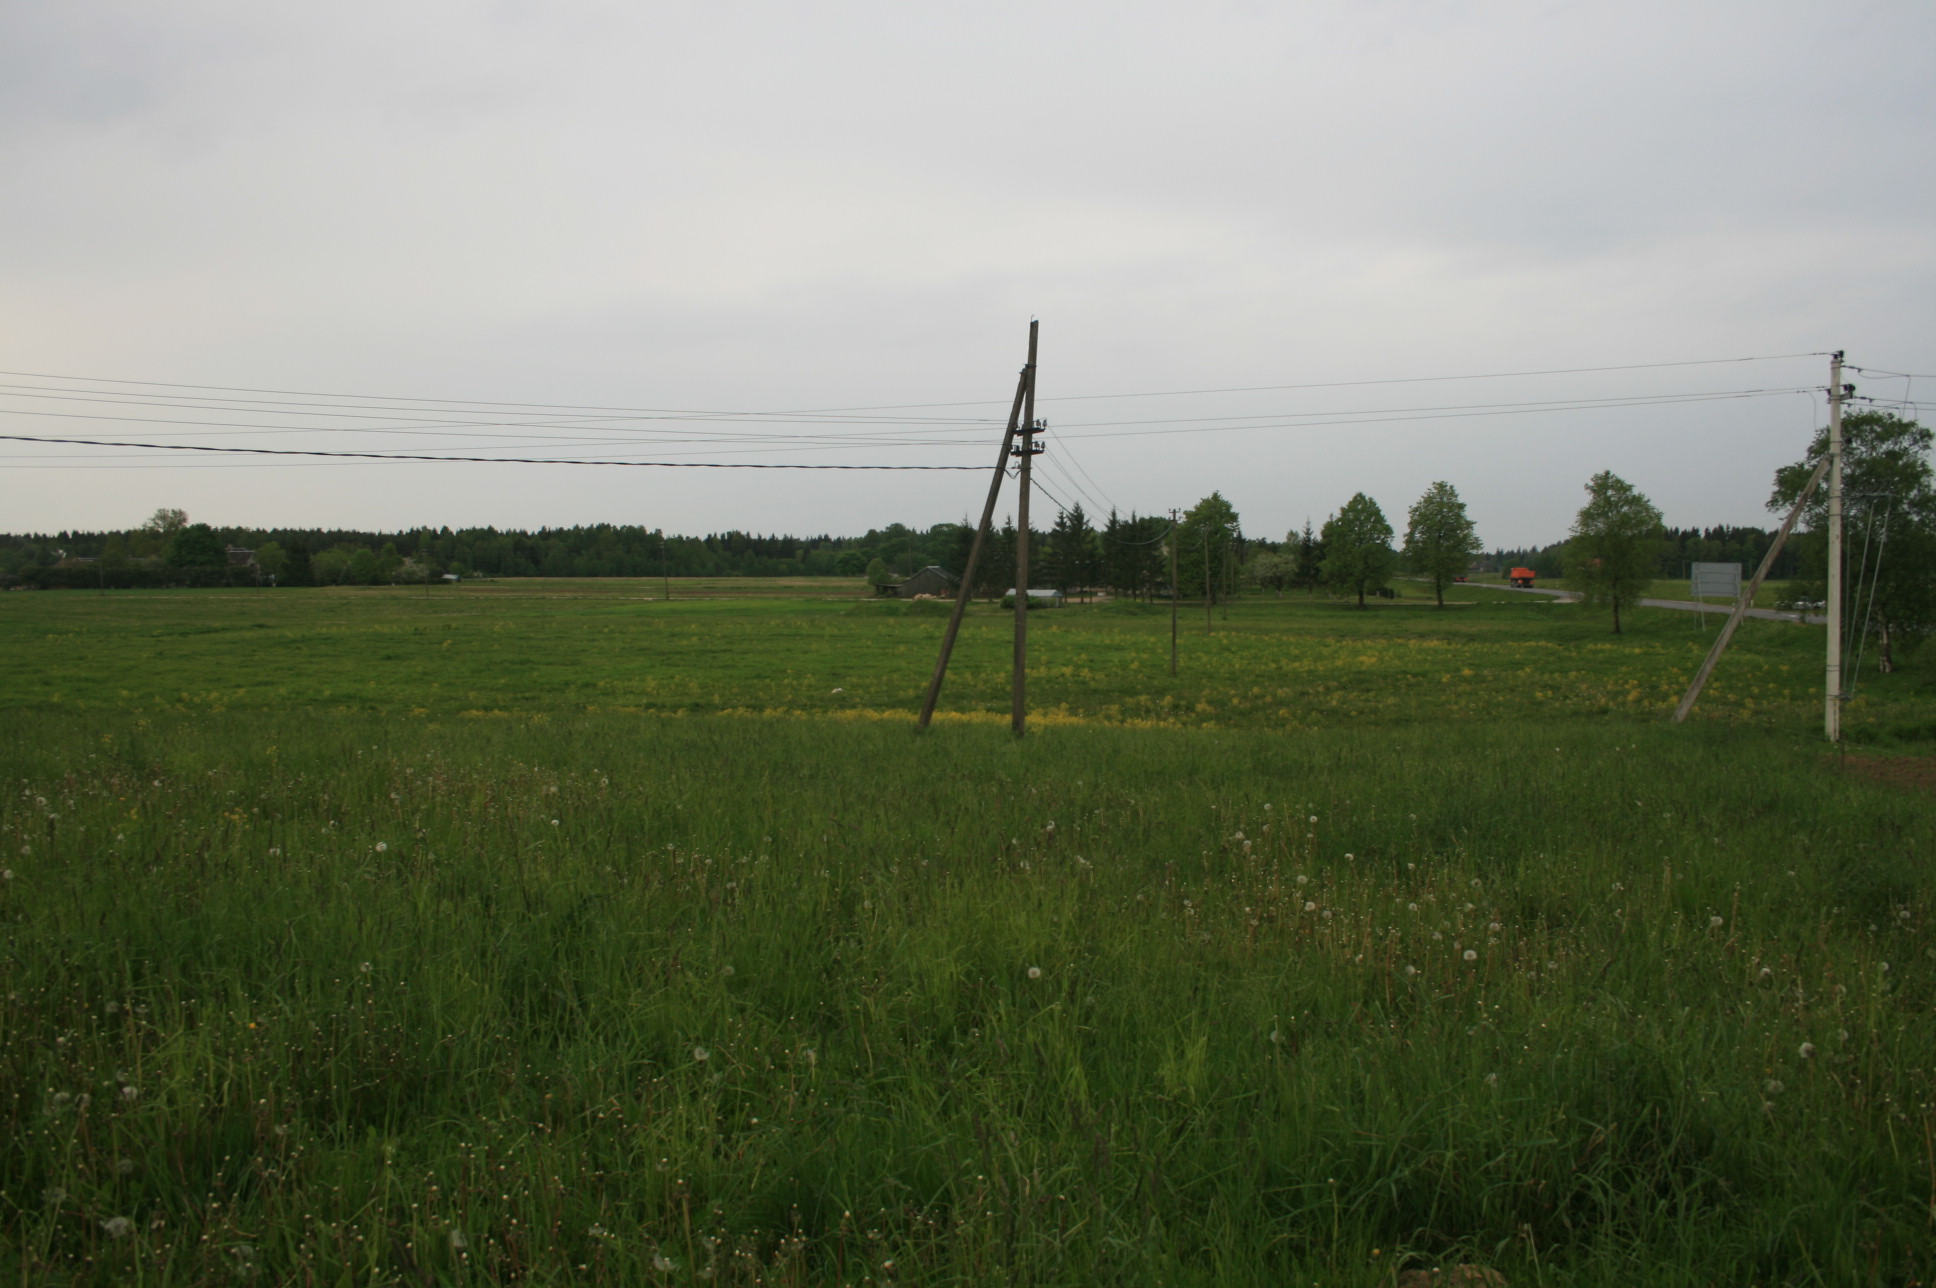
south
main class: Grassland
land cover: Grassland without tree/shrub cover
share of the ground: > 75 %
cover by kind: herbaceous plants 100 %
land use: Agriculture (excluding fallow land and kitchen gardens)
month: May
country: LT
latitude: 55.8896
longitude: 21.8657
